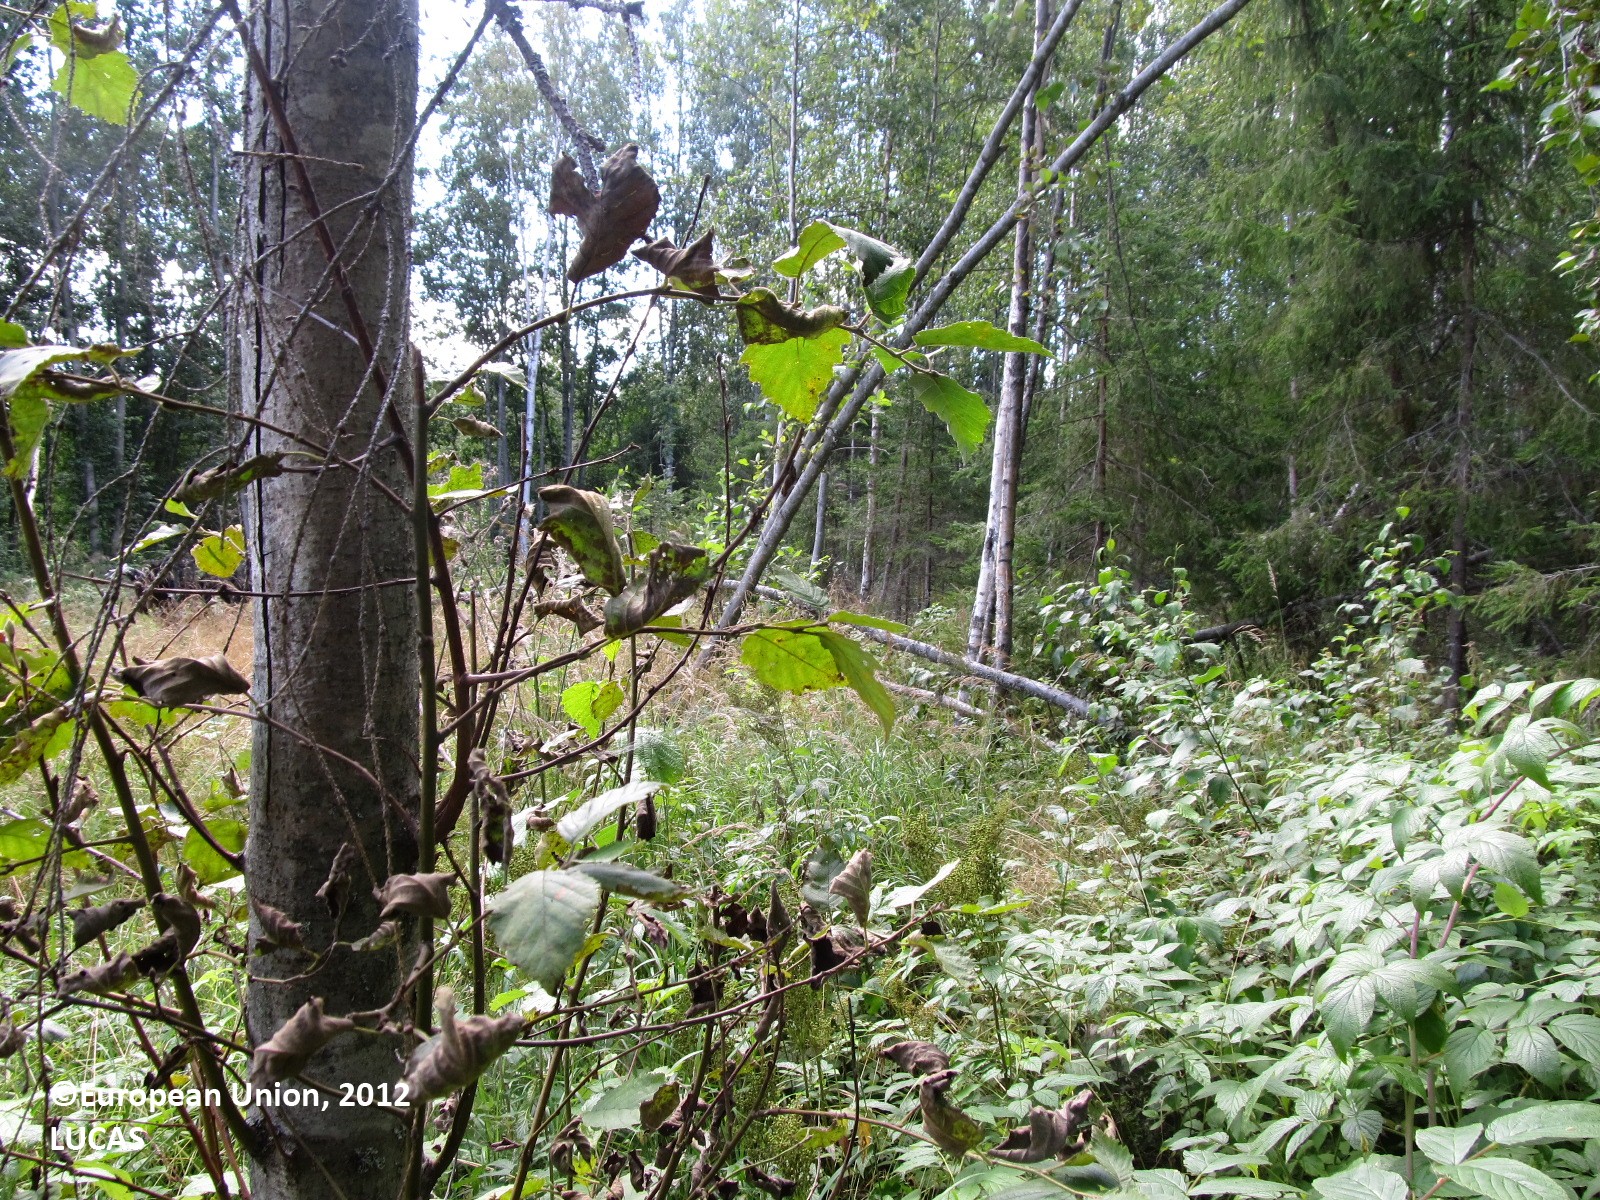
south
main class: Woodland
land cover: Spruce dominated mixed woodland
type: boreal forest
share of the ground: 25 - 50 %
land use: Forestry
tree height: > 5 m
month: August
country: FI
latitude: 62.2367
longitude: 27.5482
